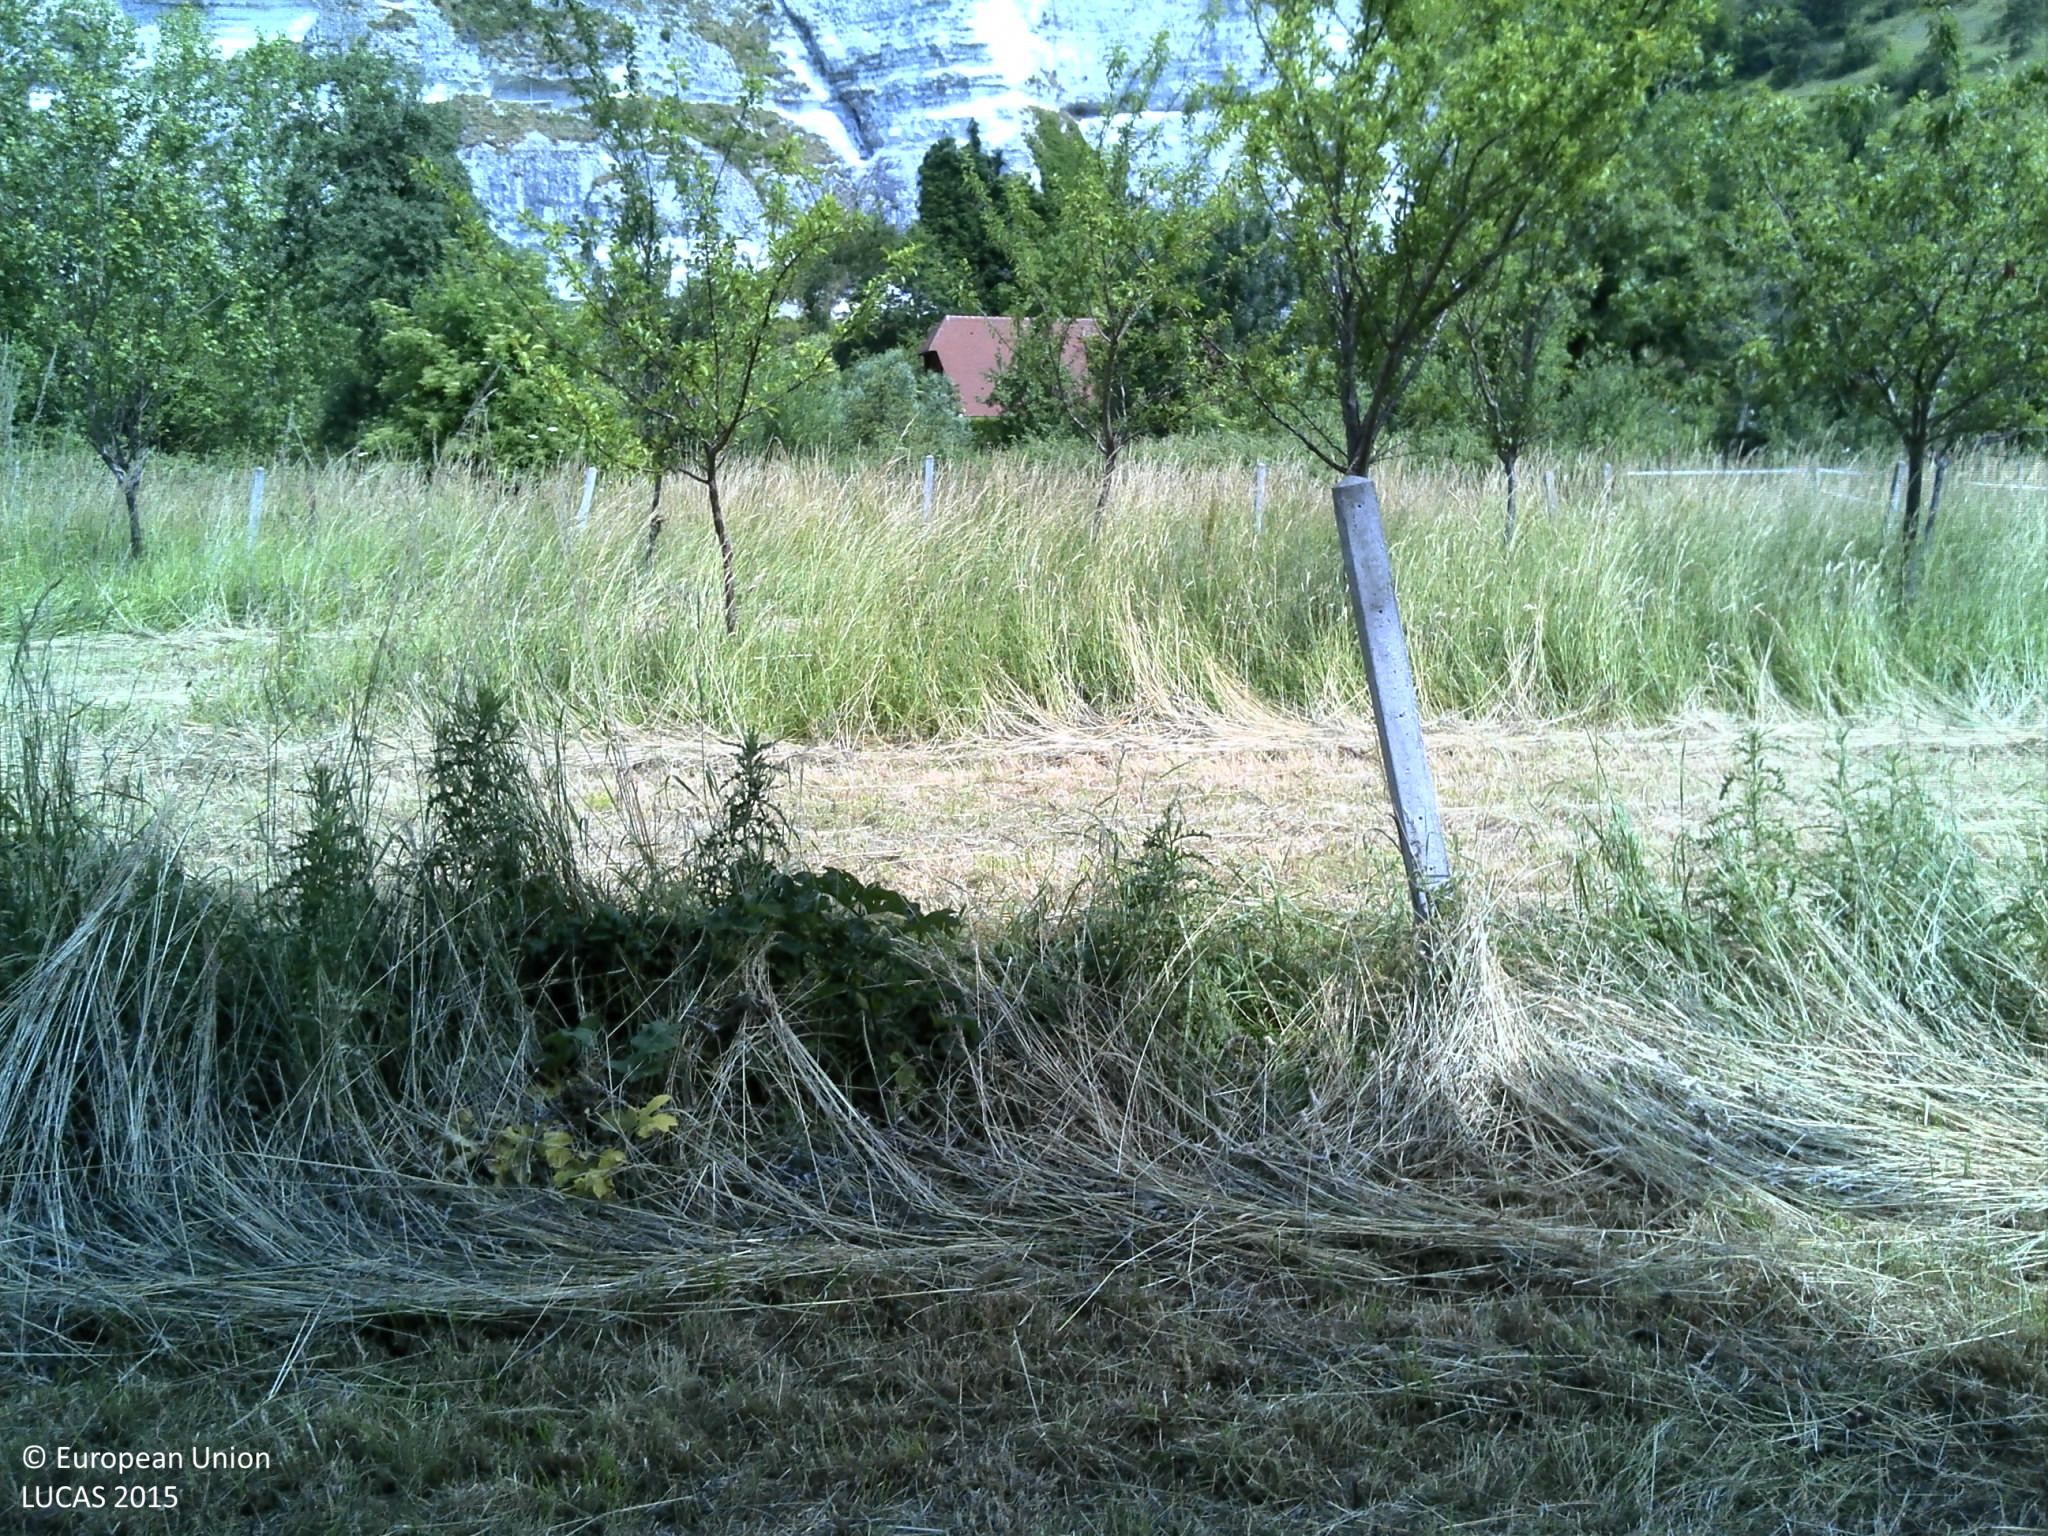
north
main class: Cropland
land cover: Nuts trees
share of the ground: 50 - 75 %
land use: Agriculture (excluding fallow land and kitchen gardens)
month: June
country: FR
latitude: 49.3227
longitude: 1.0215
